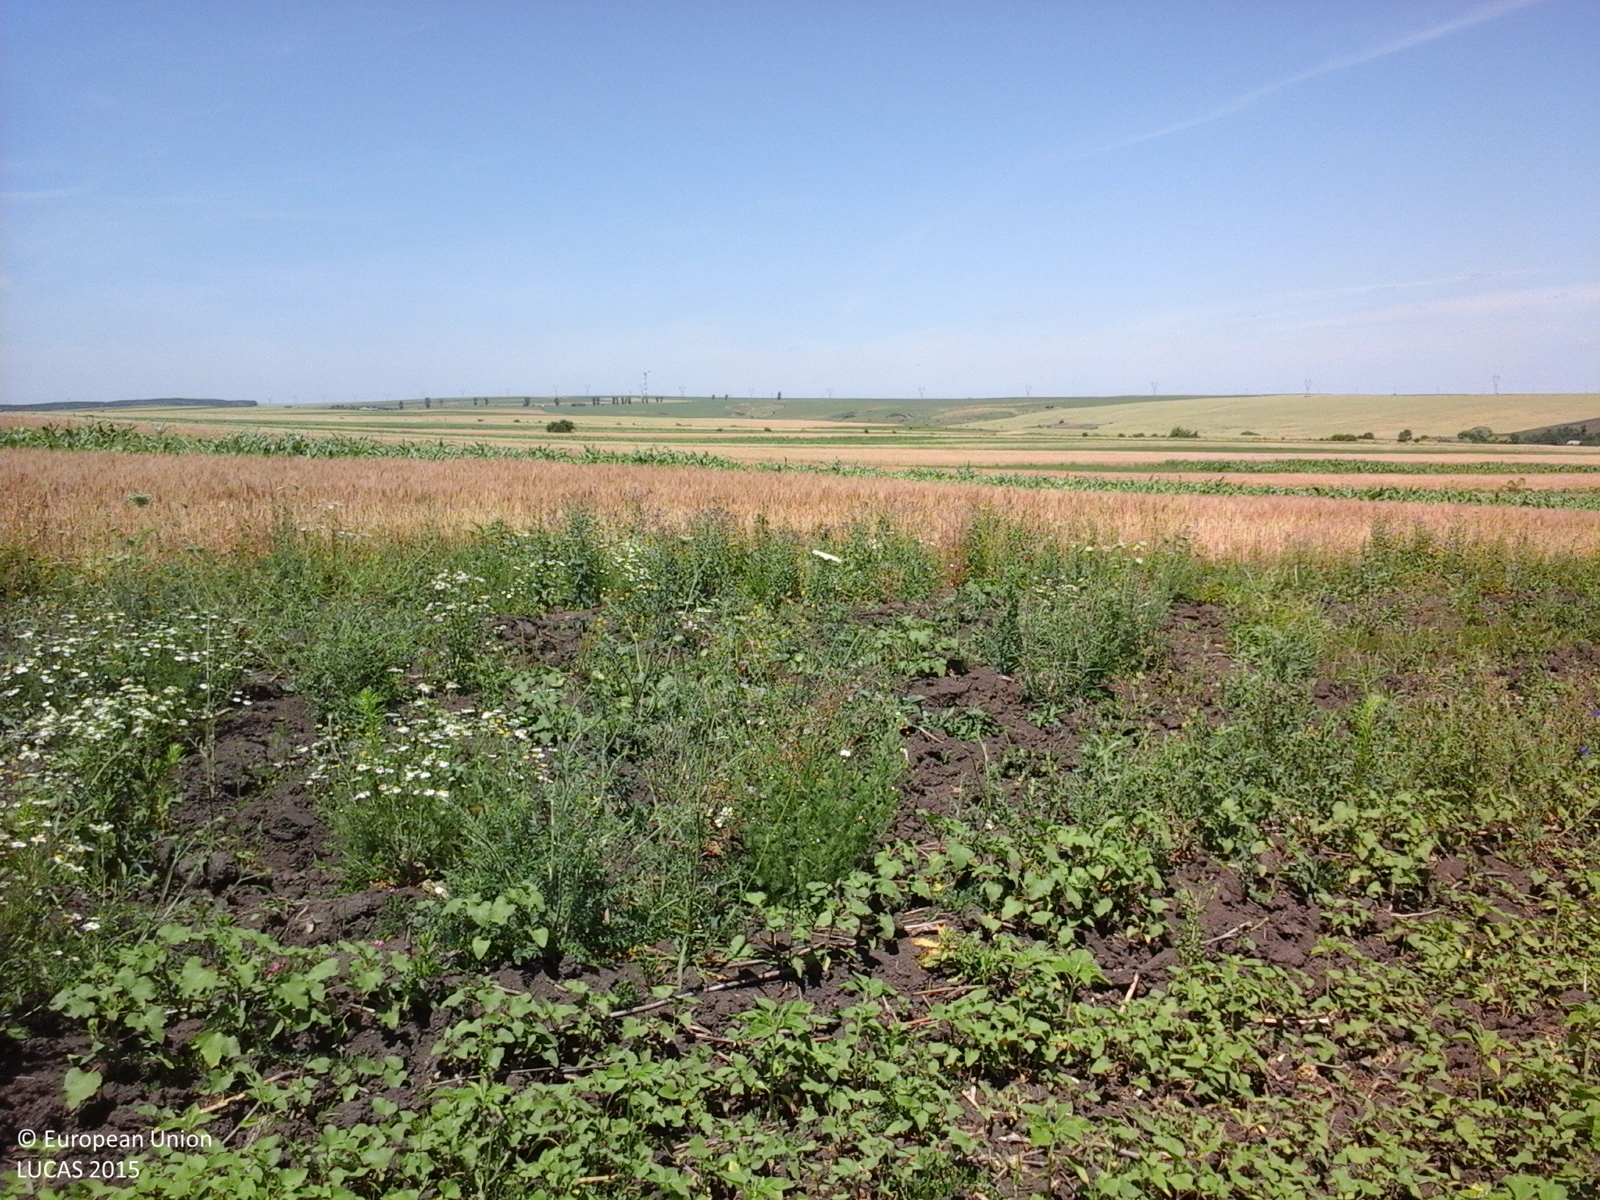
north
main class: Cropland
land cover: Sunflower
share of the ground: > 75 %
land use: Agriculture (excluding fallow land and kitchen gardens)
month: June
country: RO
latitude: 47.2522
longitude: 26.9196
